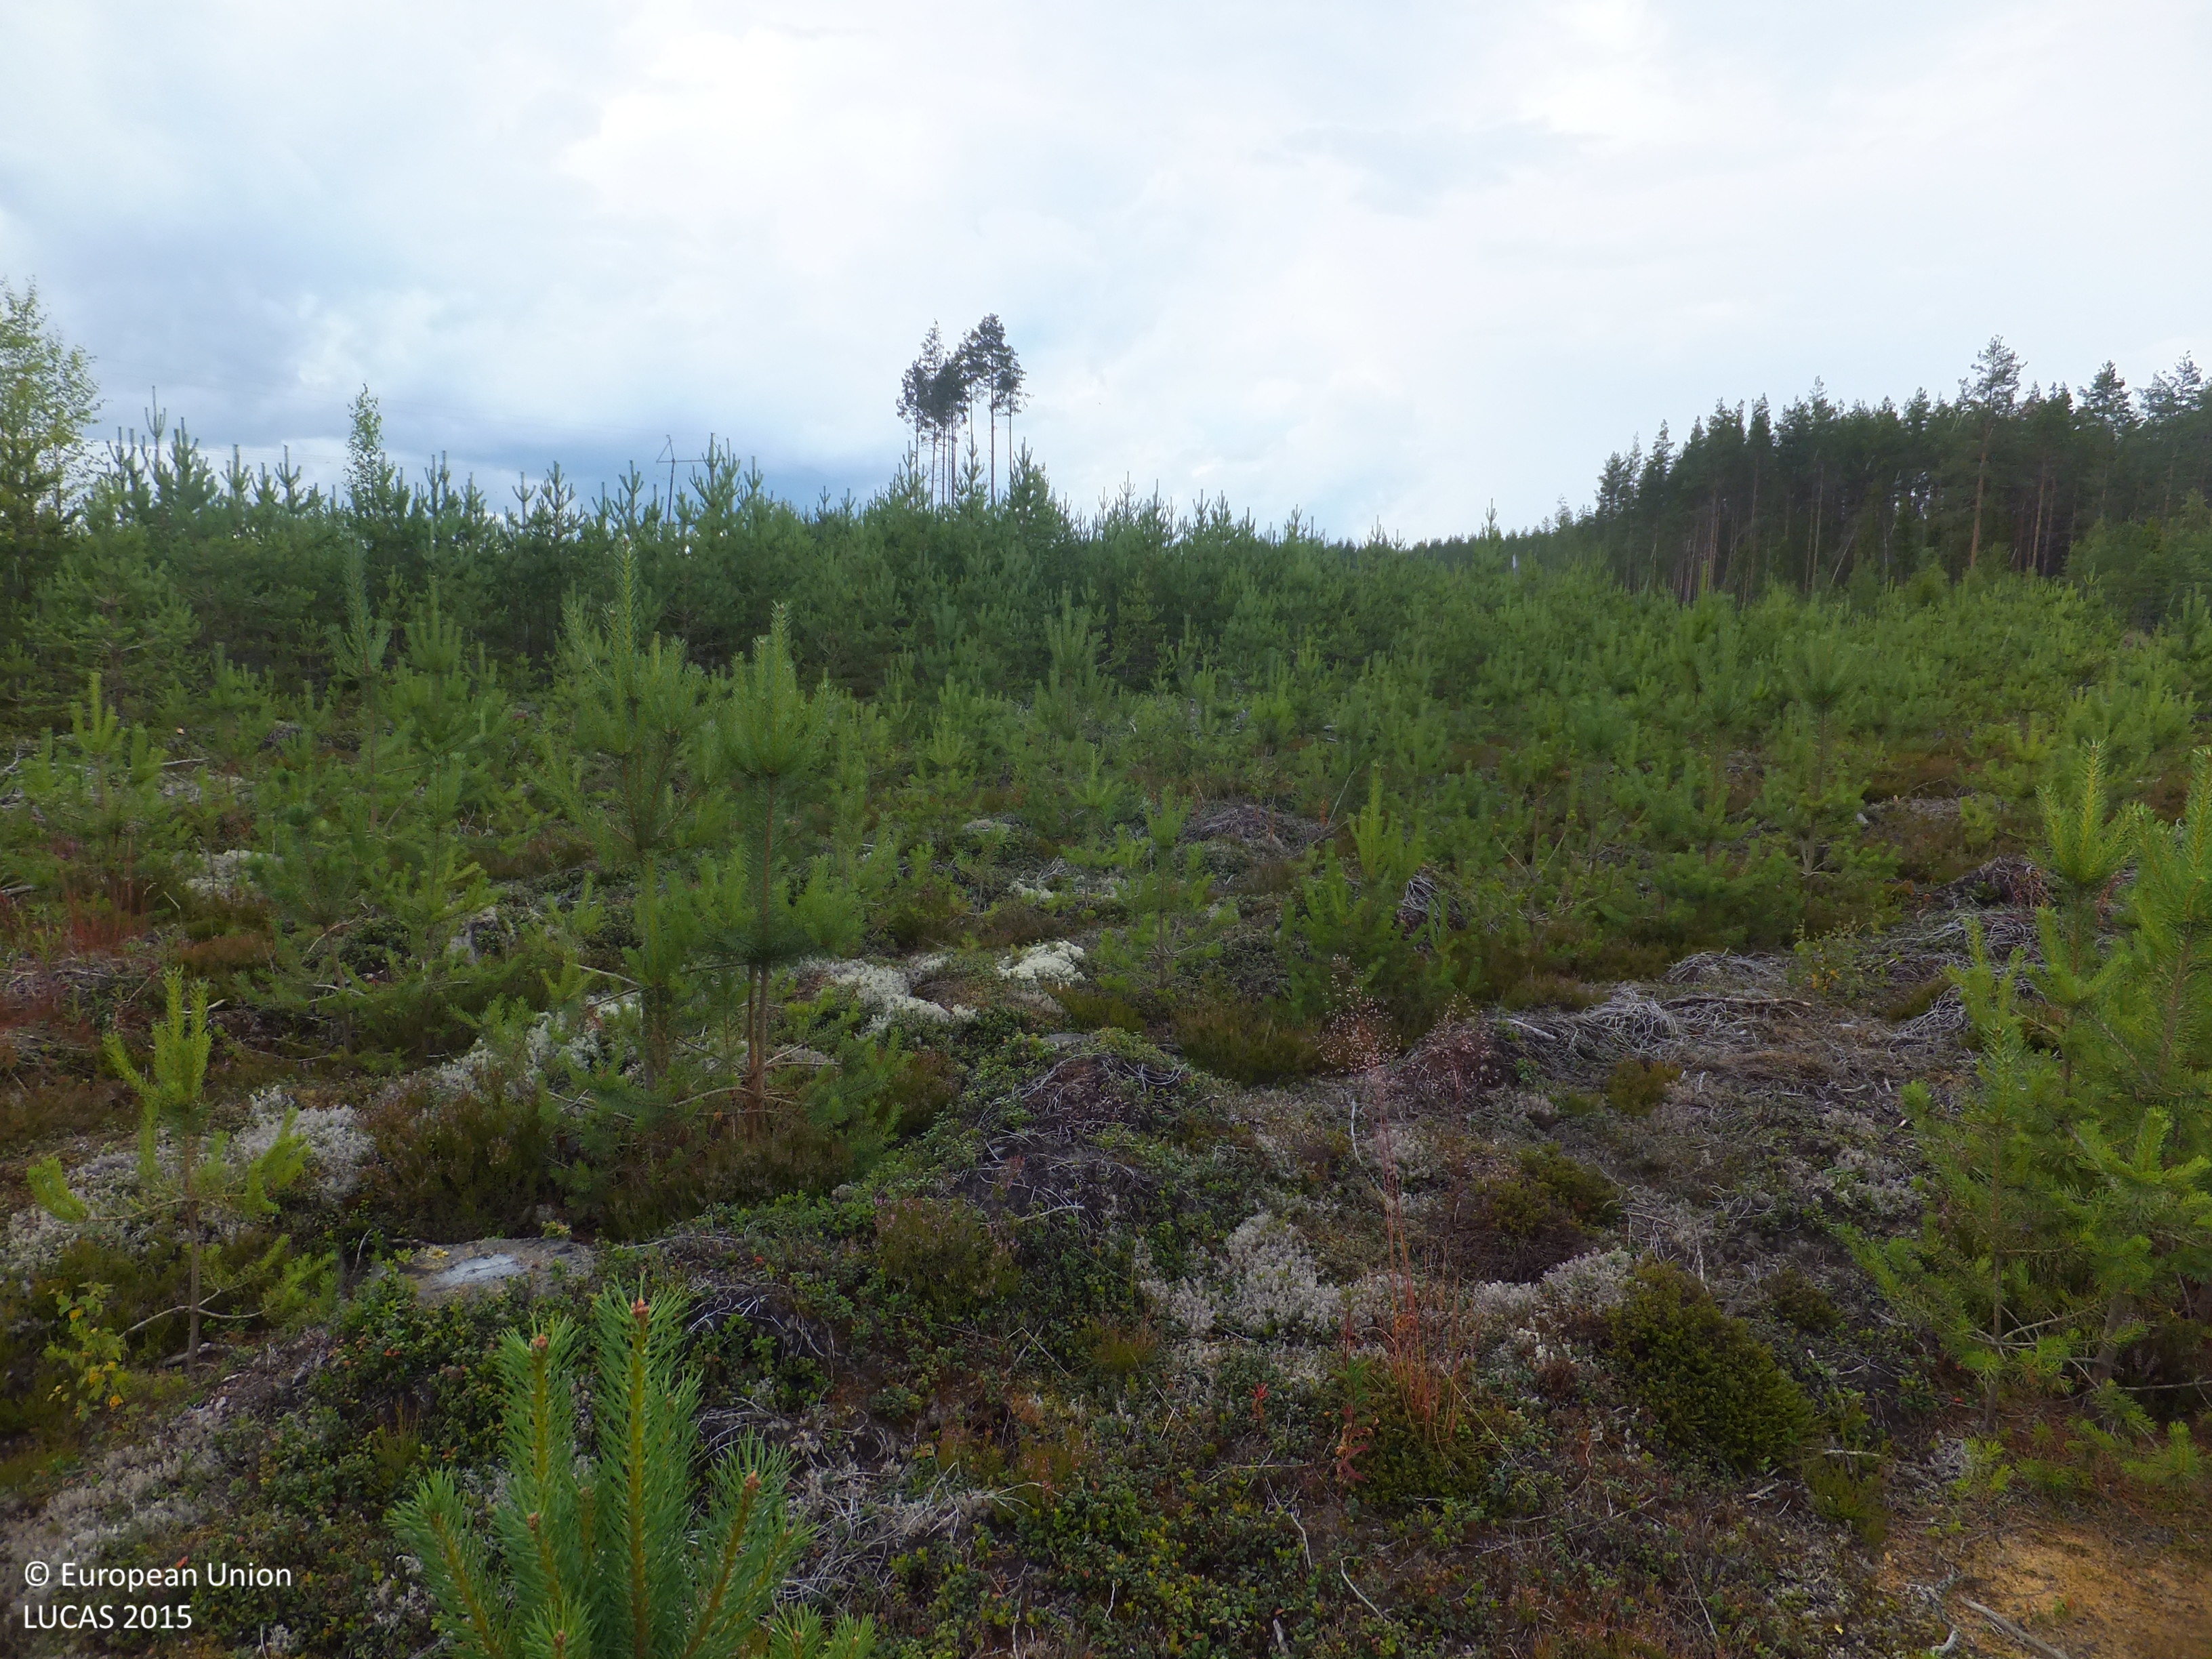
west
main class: Woodland
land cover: Pine dominated coniferous woodland
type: boreal forest
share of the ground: 25 - 50 %
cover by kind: coniferous forest trees 25 %, shrubs 20 %, lichens and mosses 20 %, unconsolidated bare surface 20 %, herbaceous plants 10 %, broadleaved forest trees 5 %
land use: Forestry
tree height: < 5 m
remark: Nursery
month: July
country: FI
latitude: 63.6040
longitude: 23.4266
